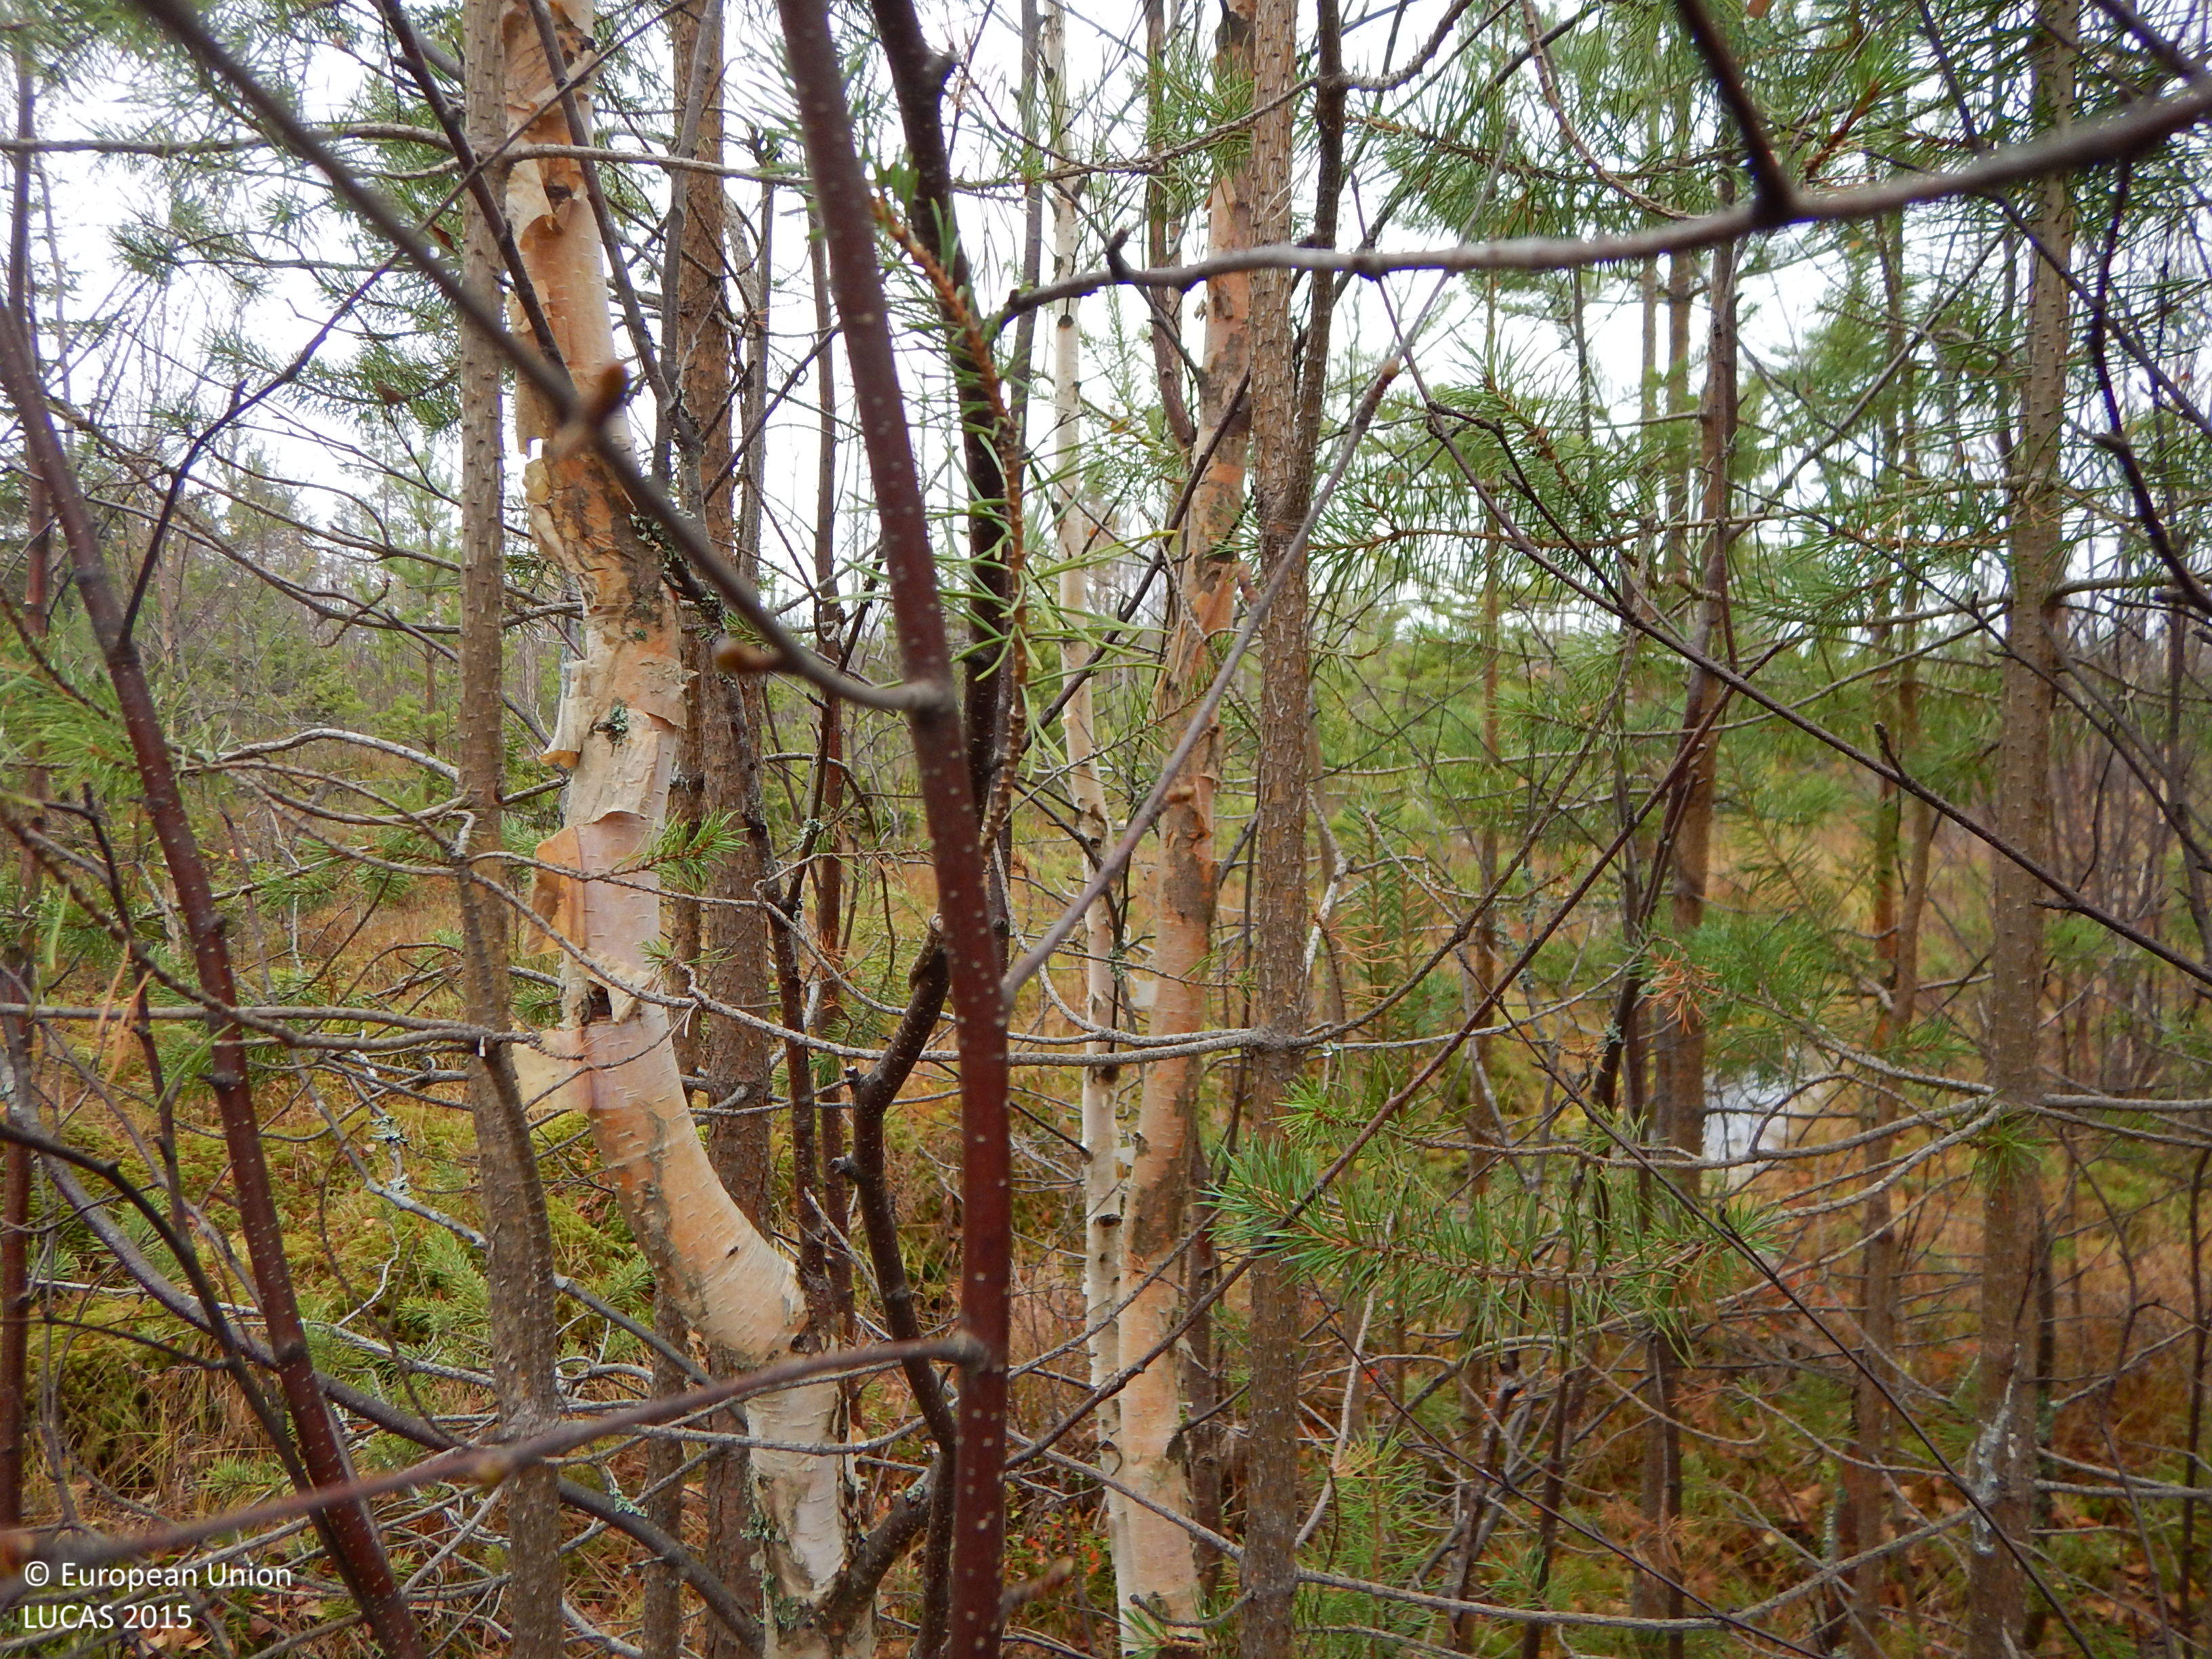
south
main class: Woodland
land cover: Other mixed woodland
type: boreal forest
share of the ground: 50 - 75 %
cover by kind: coniferous forest trees 30 %, broadleaved forest trees 20 %, shrubs 20 %, lichens and mosses 20 %, herbaceous plants 10 %
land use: Forestry
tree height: < 5 m
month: October
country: SE
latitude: 64.9558
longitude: 21.1348
